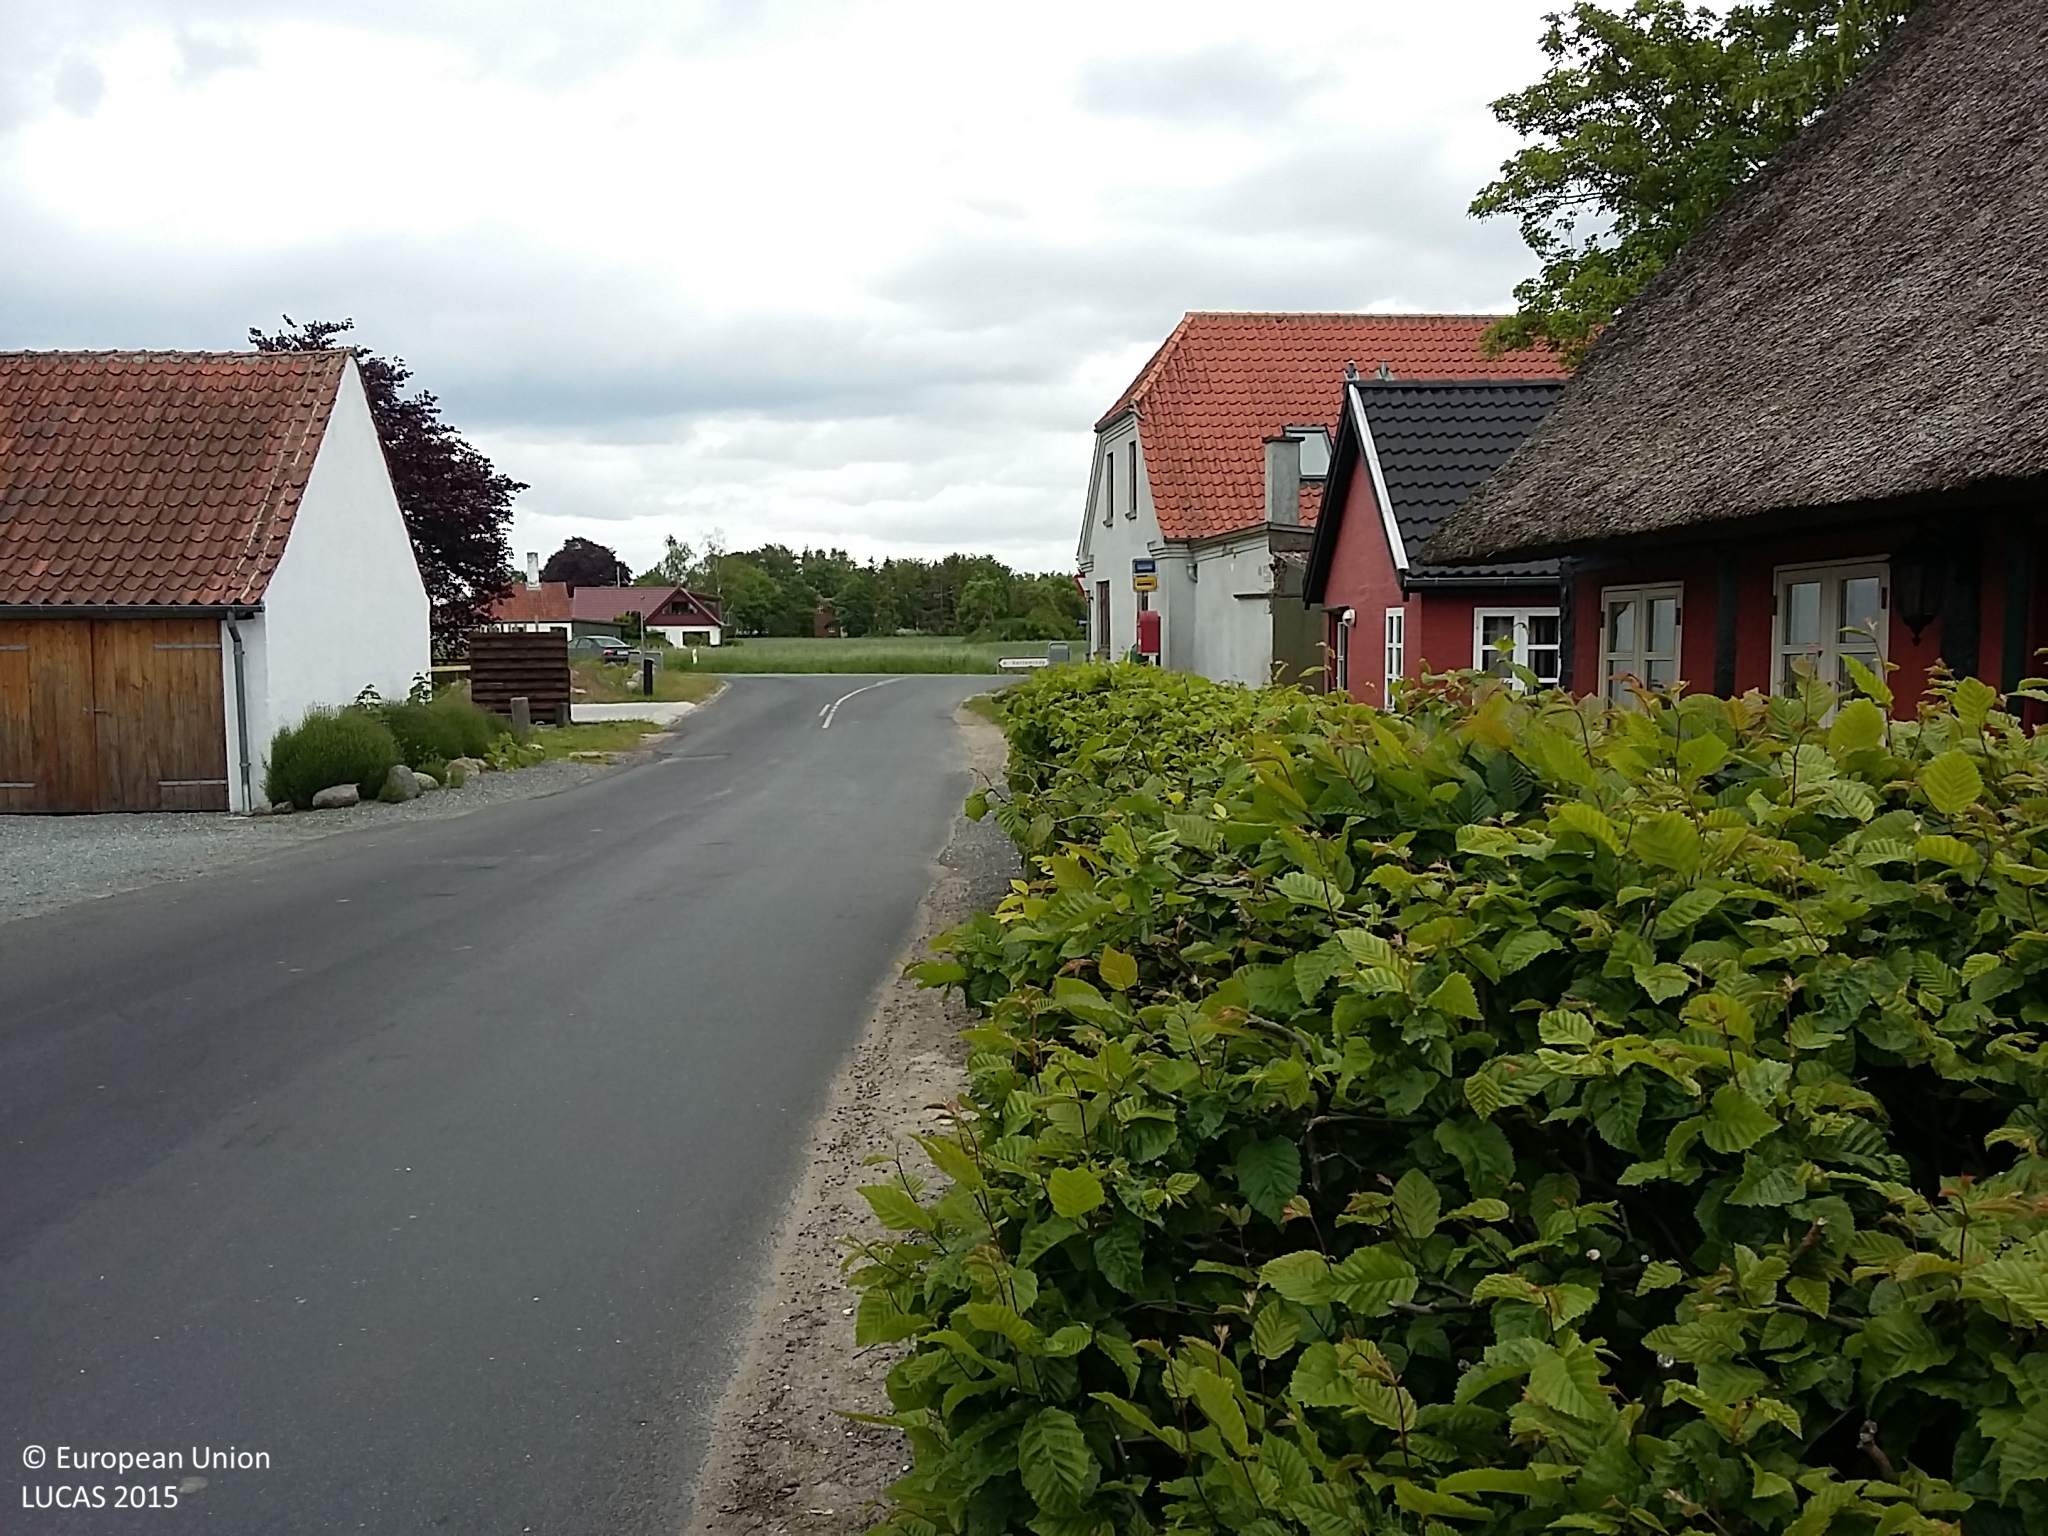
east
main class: Woodland
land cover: Broadleaved woodland
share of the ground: 25 - 50 %
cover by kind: herbaceous plants 60 %, broadleaved forest trees 40 %
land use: Residential
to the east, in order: Broadleaved woodland; Artificial constructions in urban areas; Common wheat; Artificial constructions in urban areas; Common wheat
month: June
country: DK
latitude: 55.4313
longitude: 10.6158
